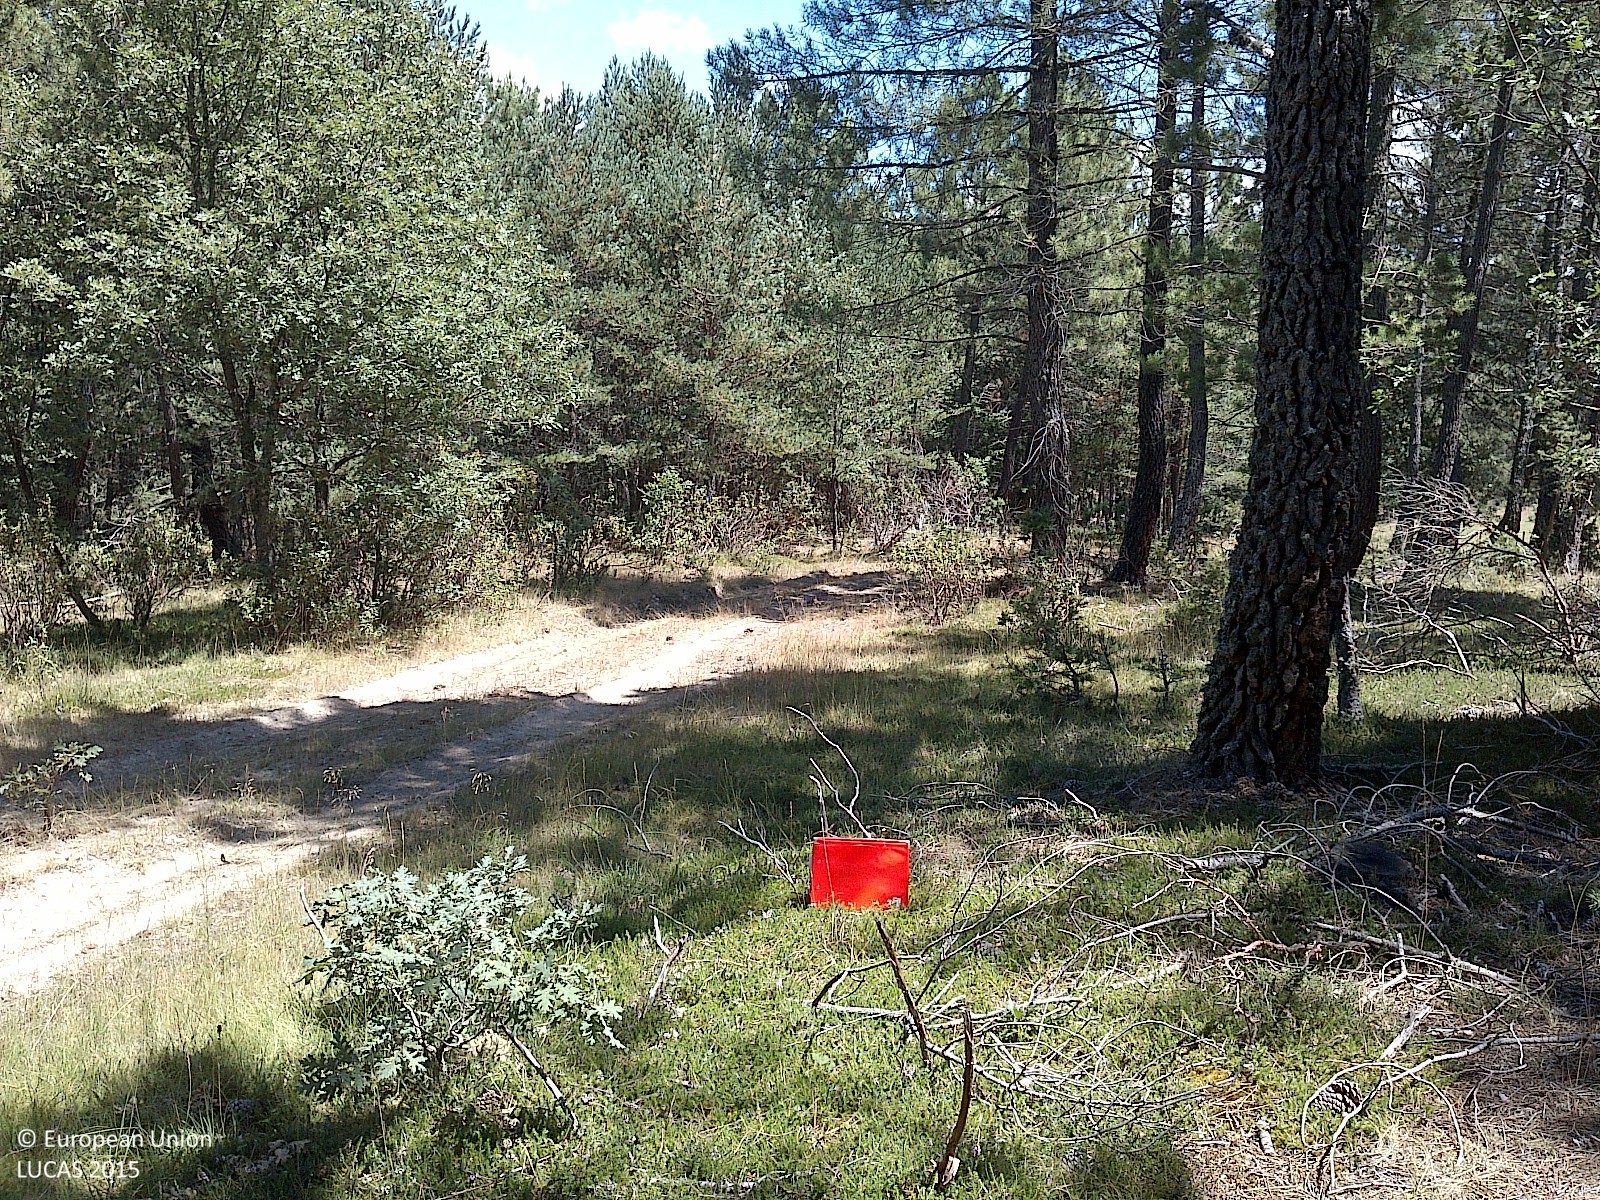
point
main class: Woodland
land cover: Pine dominated coniferous woodland
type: coniferous forest of the mediterranean region
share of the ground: > 75 %
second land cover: Grassland without tree/shrub cover
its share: 50 - 75 %
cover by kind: coniferous forest trees 80 %, herbaceous plants 15 %, shrubs 5 %
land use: Forestry
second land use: Agriculture (excluding fallow land and kitchen gardens)
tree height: > 5 m
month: July
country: ES
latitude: 41.8812
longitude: -3.1708
